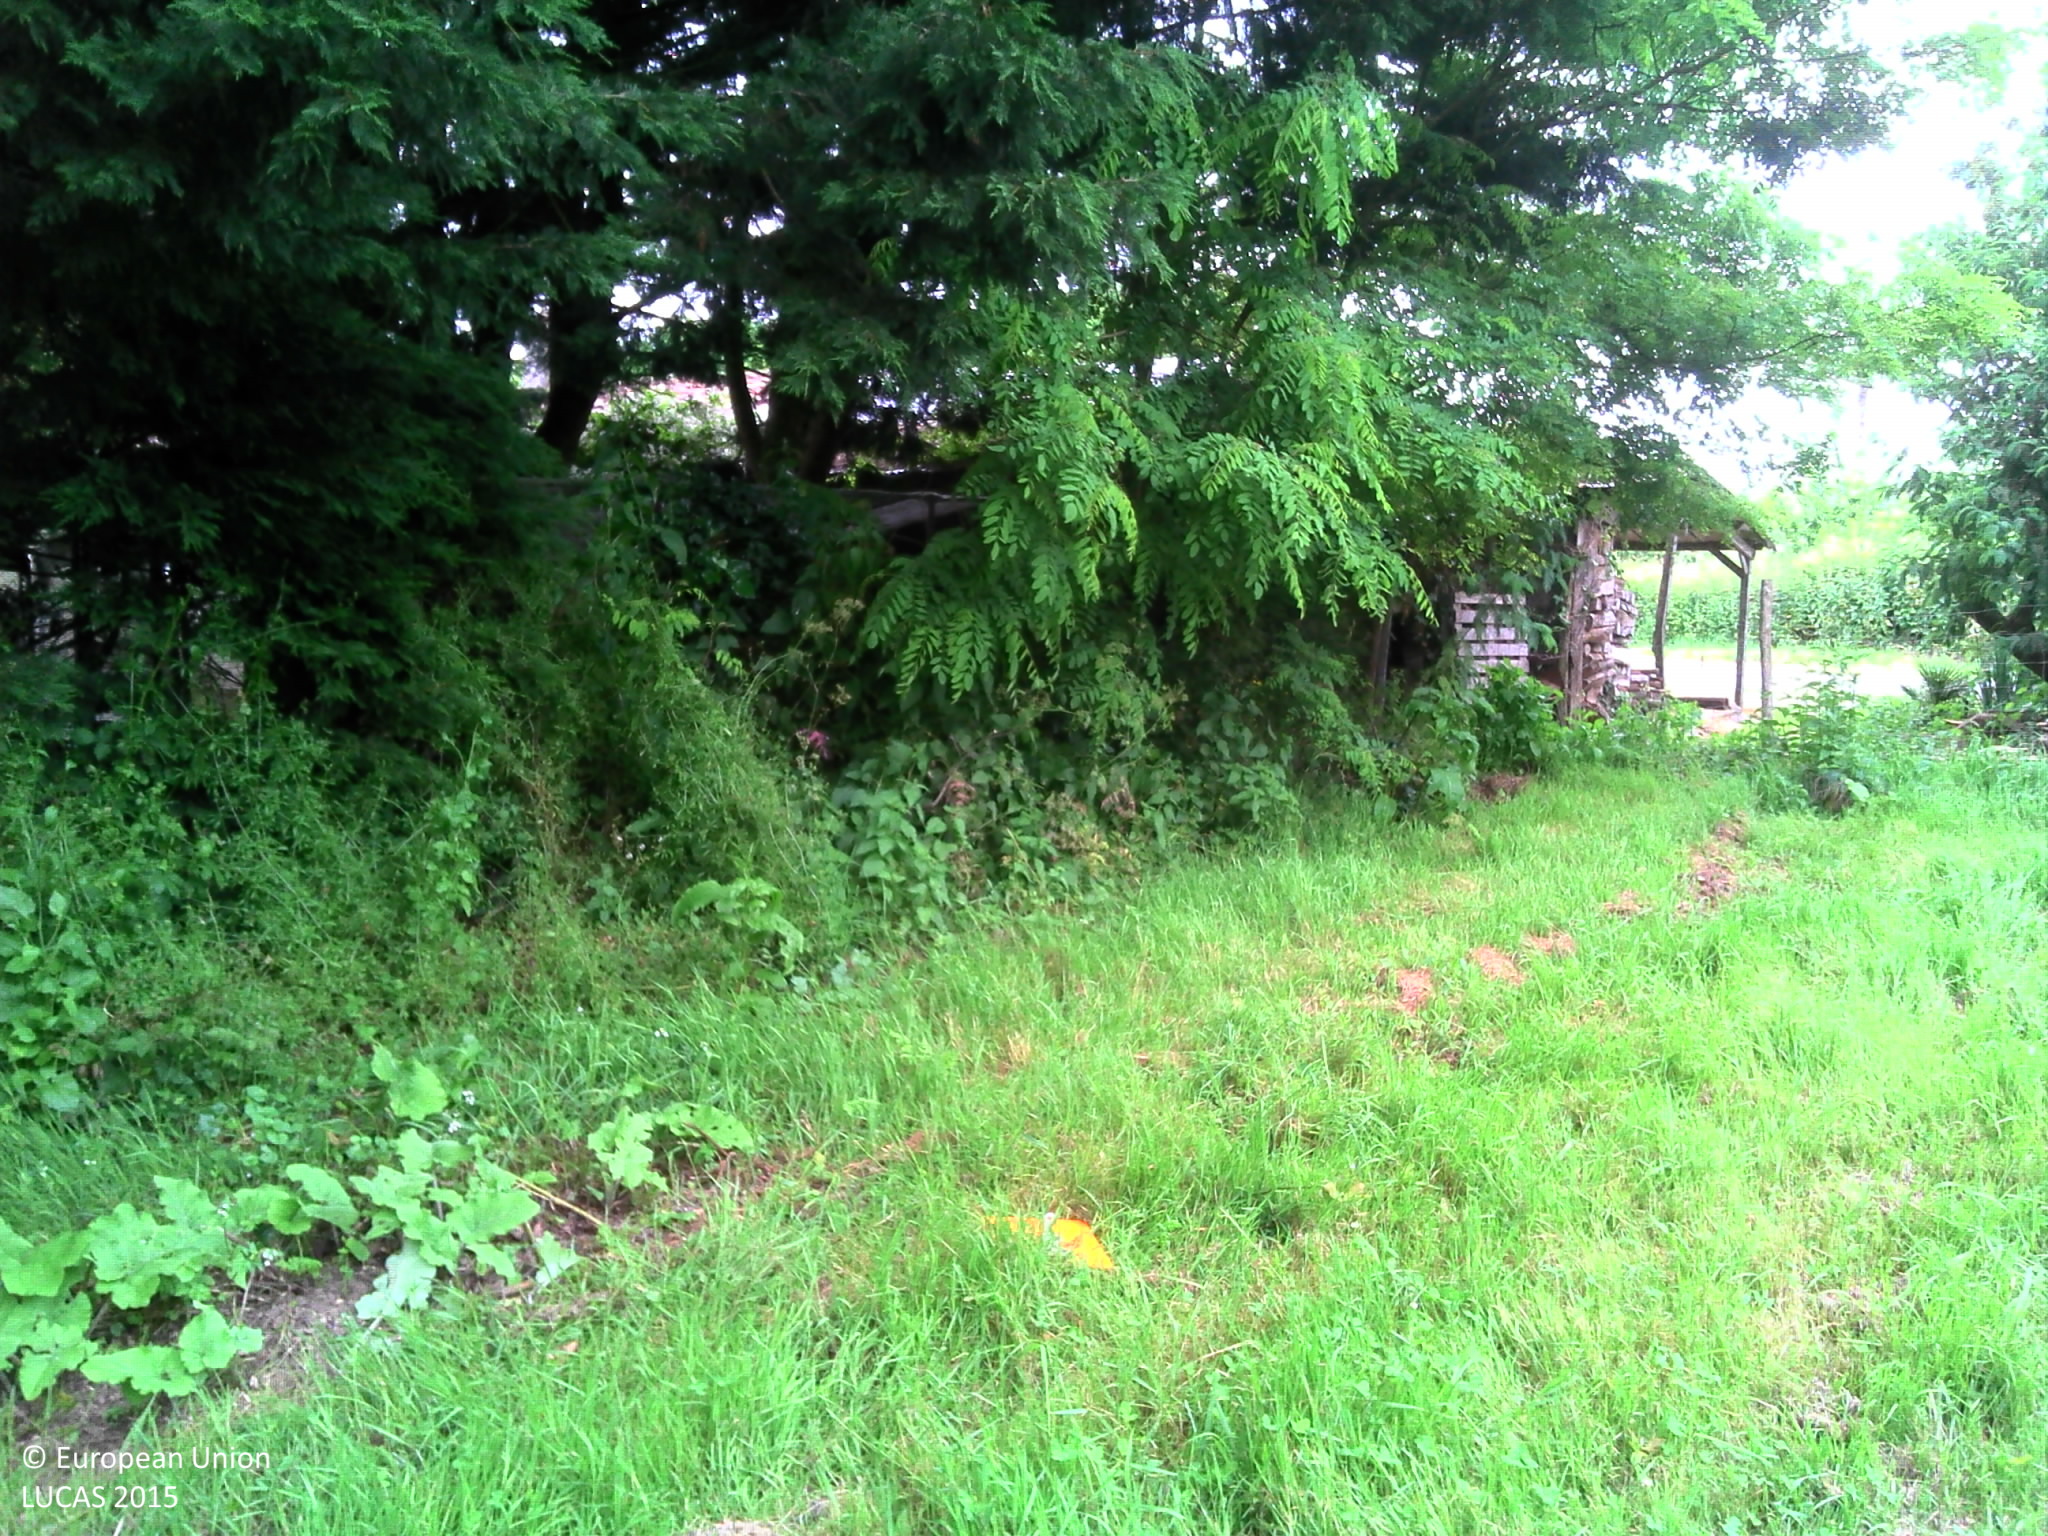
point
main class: Grassland
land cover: Grassland with sparse tree/shrub cover
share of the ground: > 75 %
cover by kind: herbaceous plants 95 %, broadleaved forest trees 5 %
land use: Residential
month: June
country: FR
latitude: 46.8439
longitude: -1.7794
